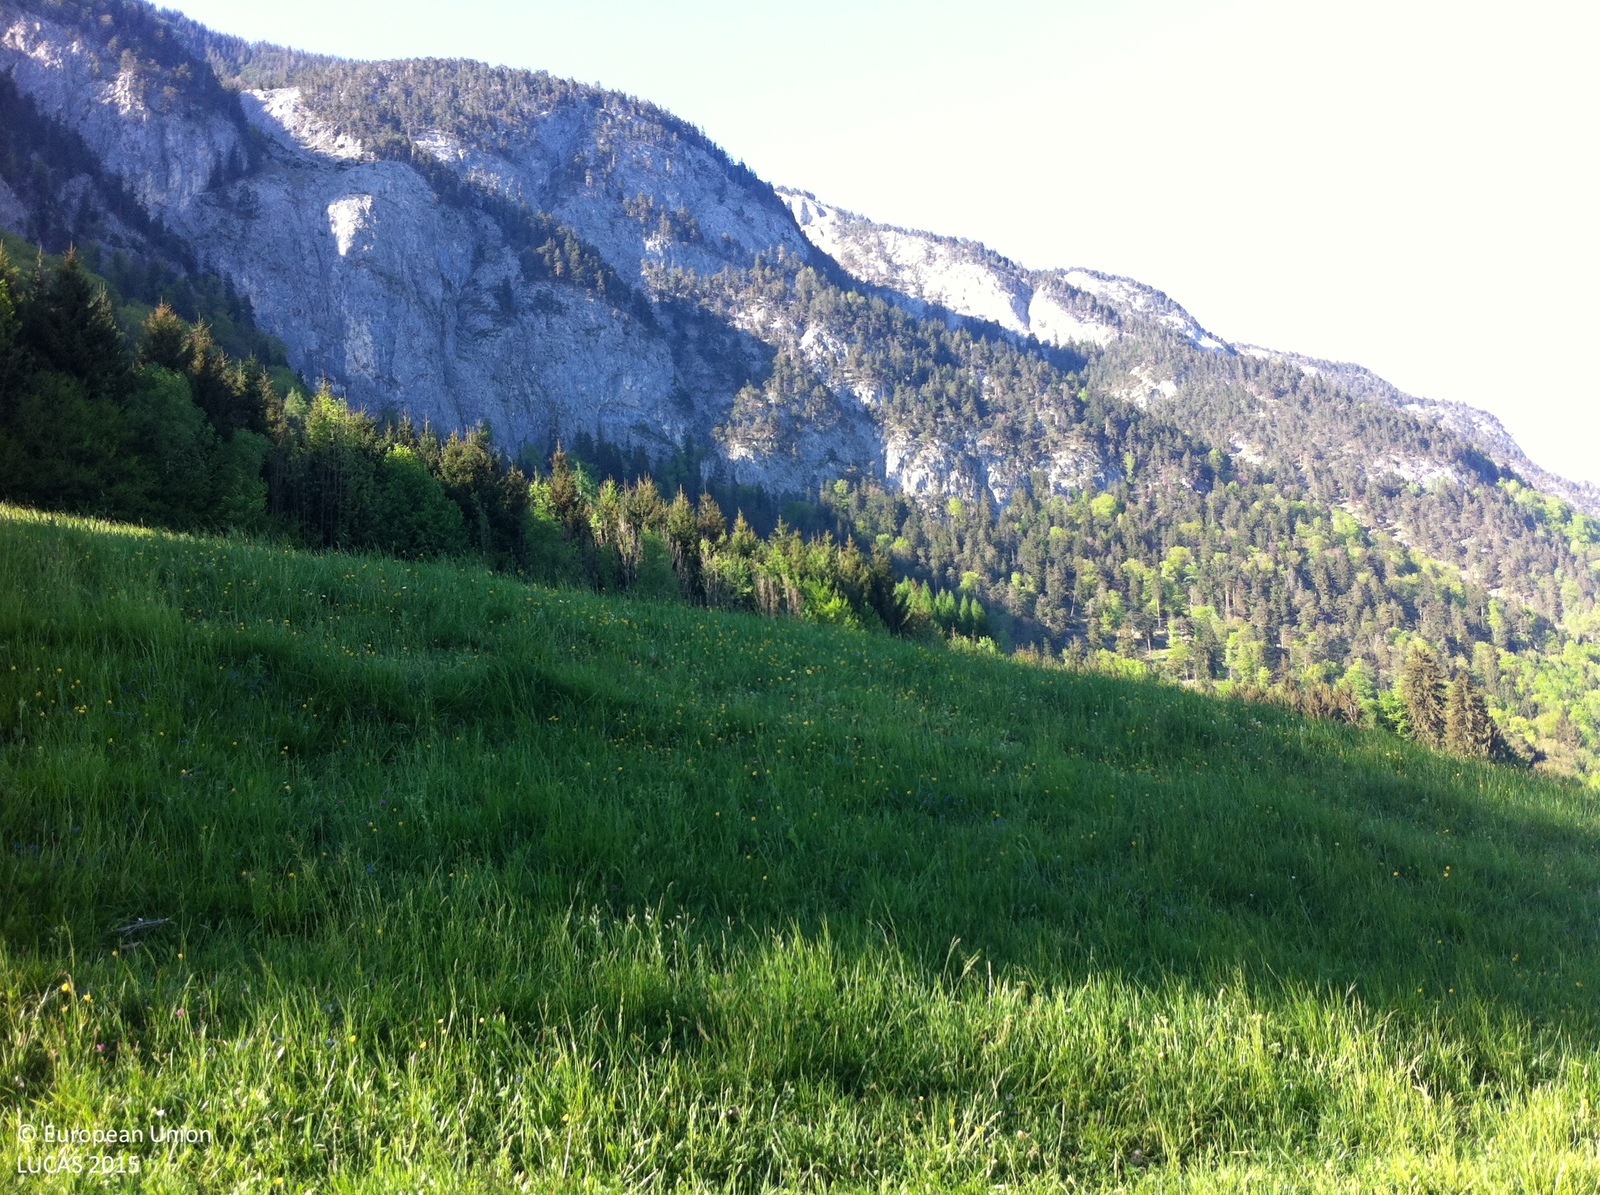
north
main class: Grassland
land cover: Grassland without tree/shrub cover
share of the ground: > 75 %
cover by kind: herbaceous plants 100 %
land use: Agriculture (excluding fallow land and kitchen gardens)
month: May
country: AT
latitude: 47.3818
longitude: 11.7337
